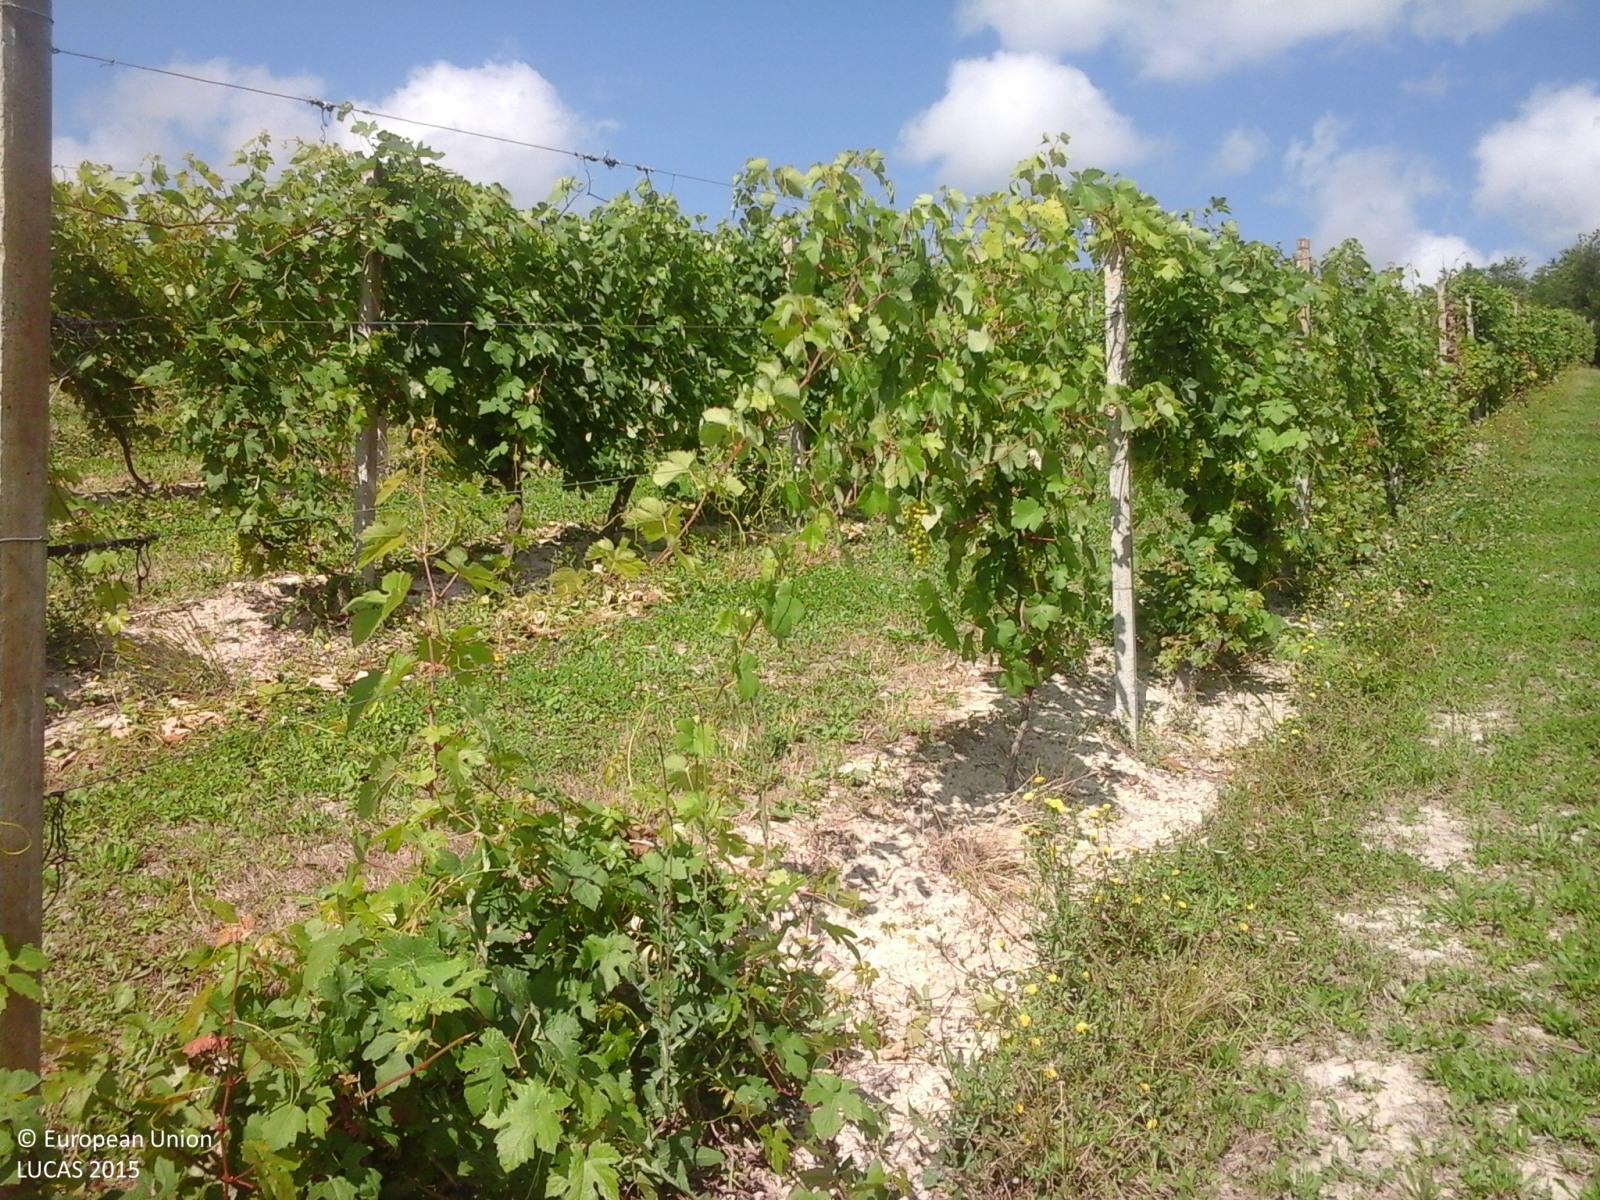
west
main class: Cropland
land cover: Vineyards
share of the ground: > 75 %
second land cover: Grassland without tree/shrub cover
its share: > 75 %
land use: Agriculture (excluding fallow land and kitchen gardens)
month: June
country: IT
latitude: 45.0779
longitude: 8.4150
